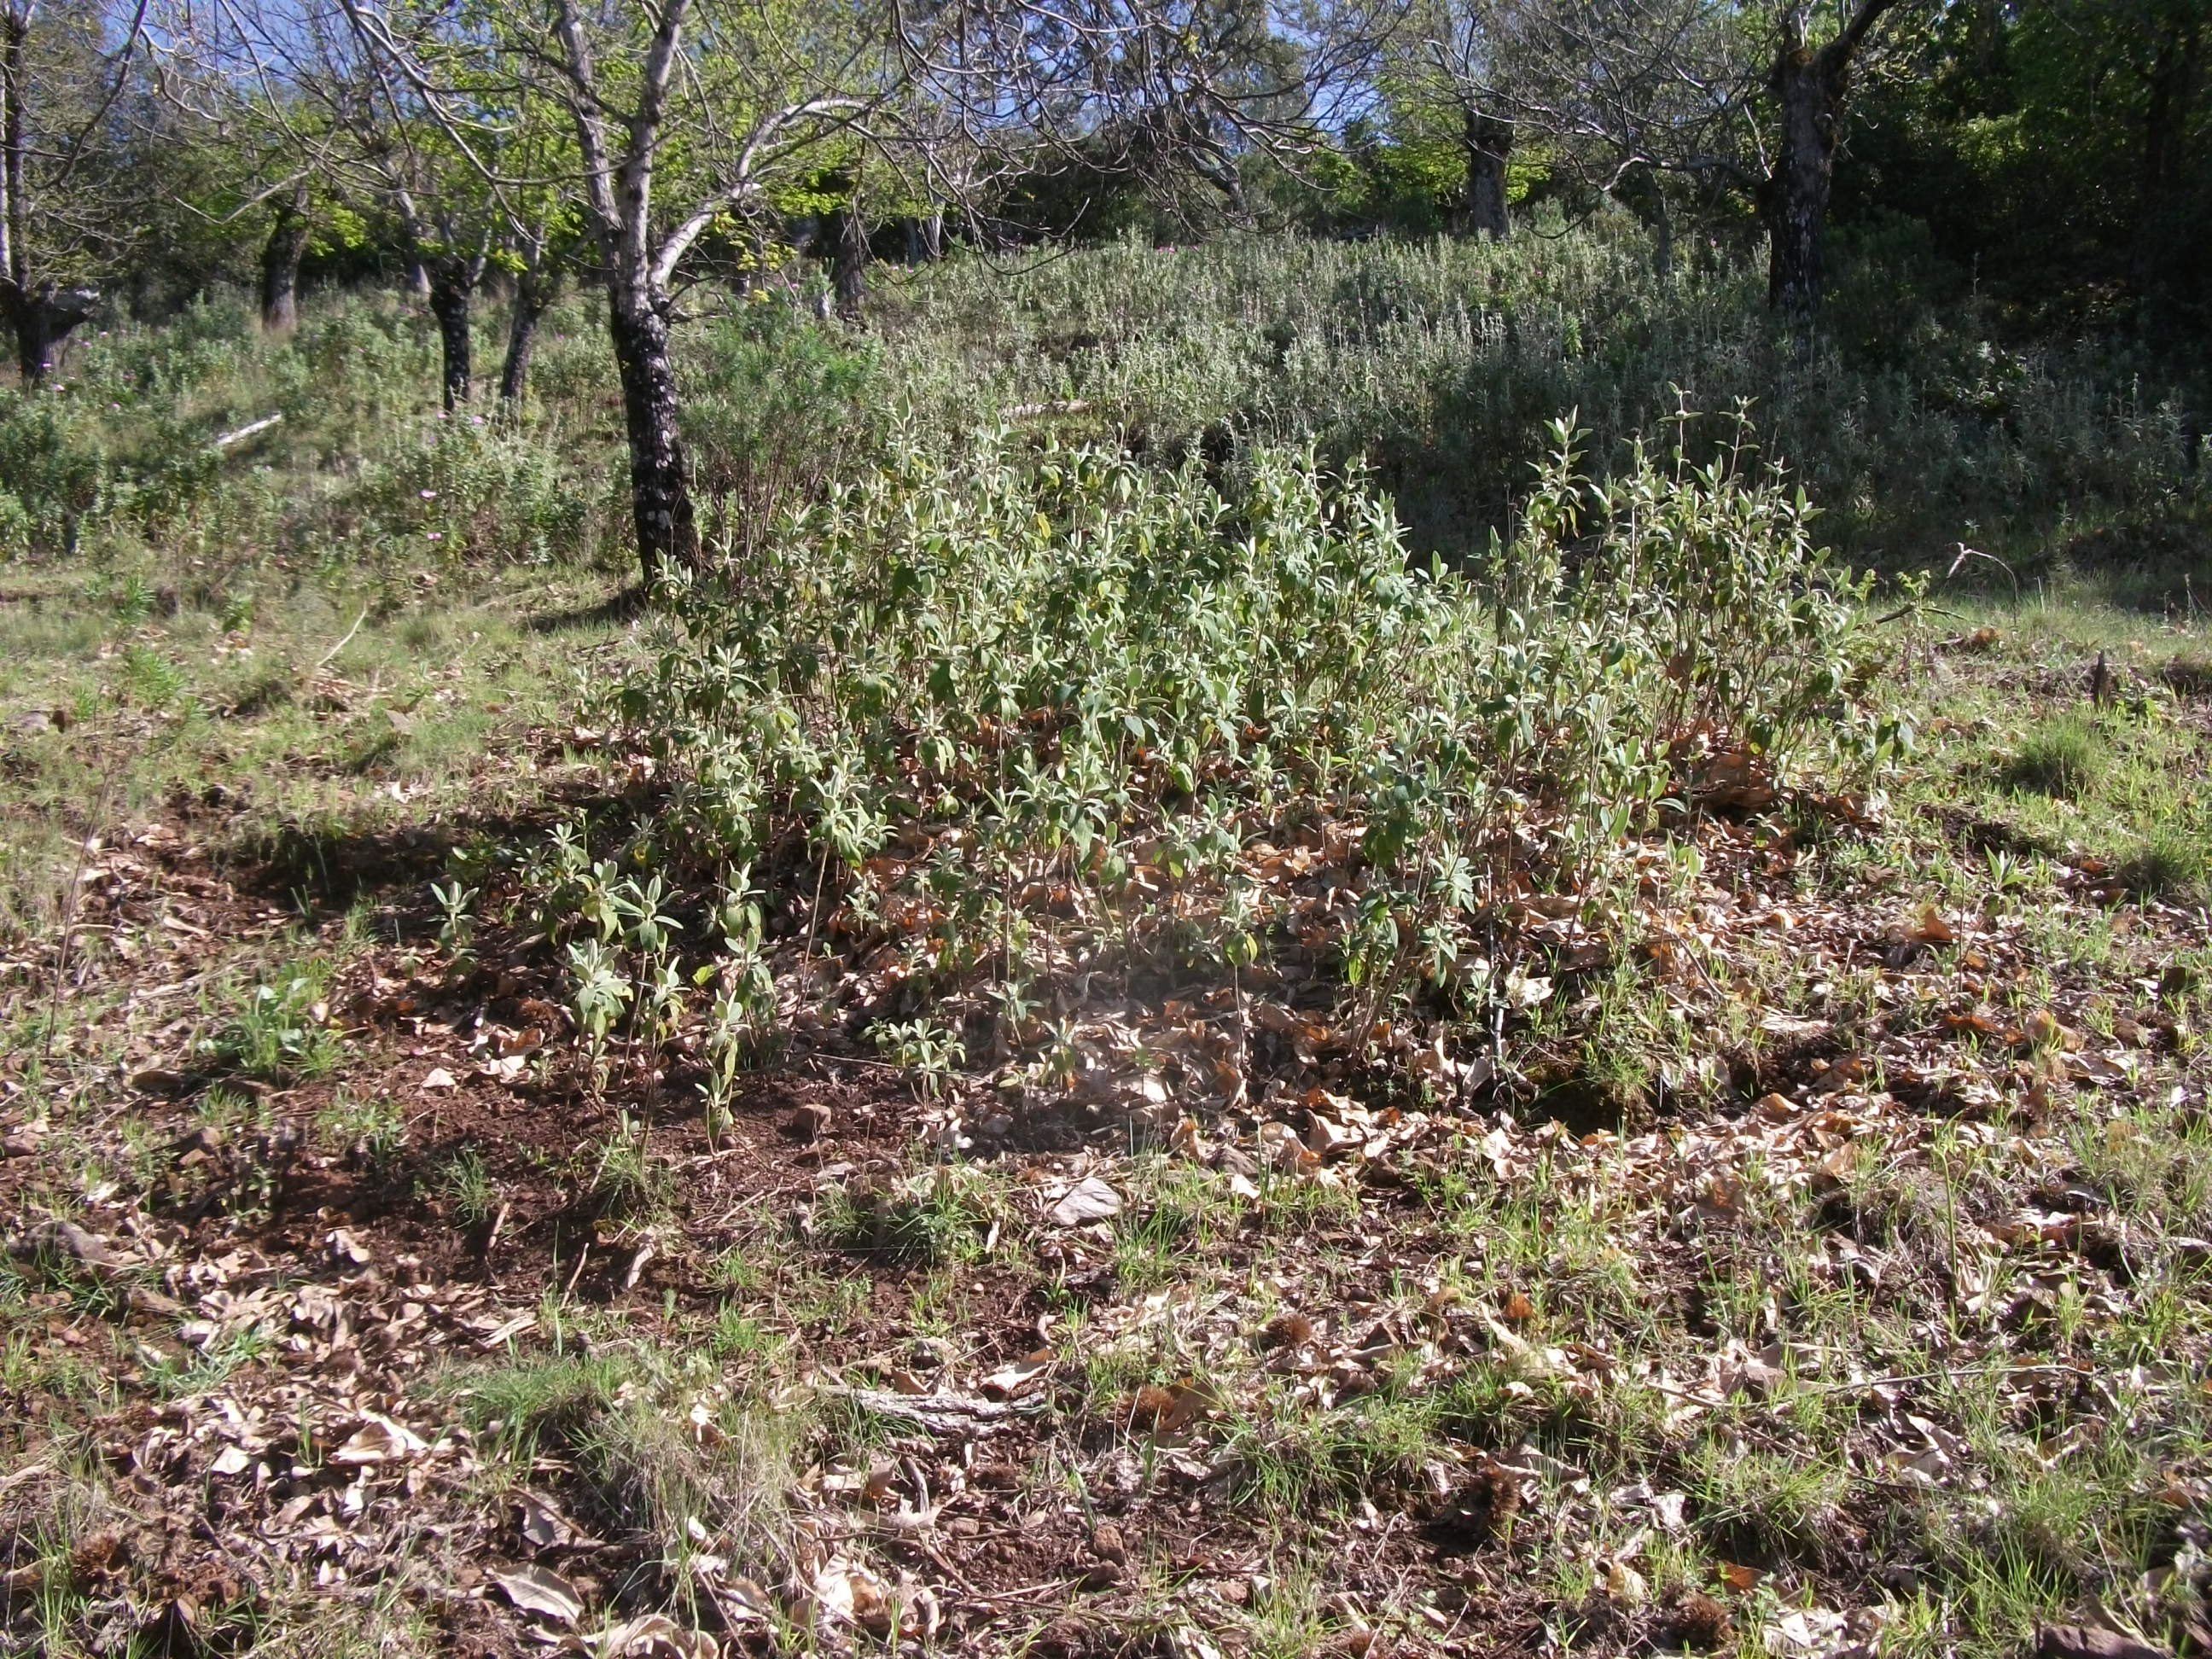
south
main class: Cropland
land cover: Nuts trees
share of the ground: 50 - 75 %
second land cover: Spontaneously vegetated surfaces
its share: > 75 %
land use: Agriculture (excluding fallow land and kitchen gardens)
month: April
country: ES
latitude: 37.8815
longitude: -6.6096
